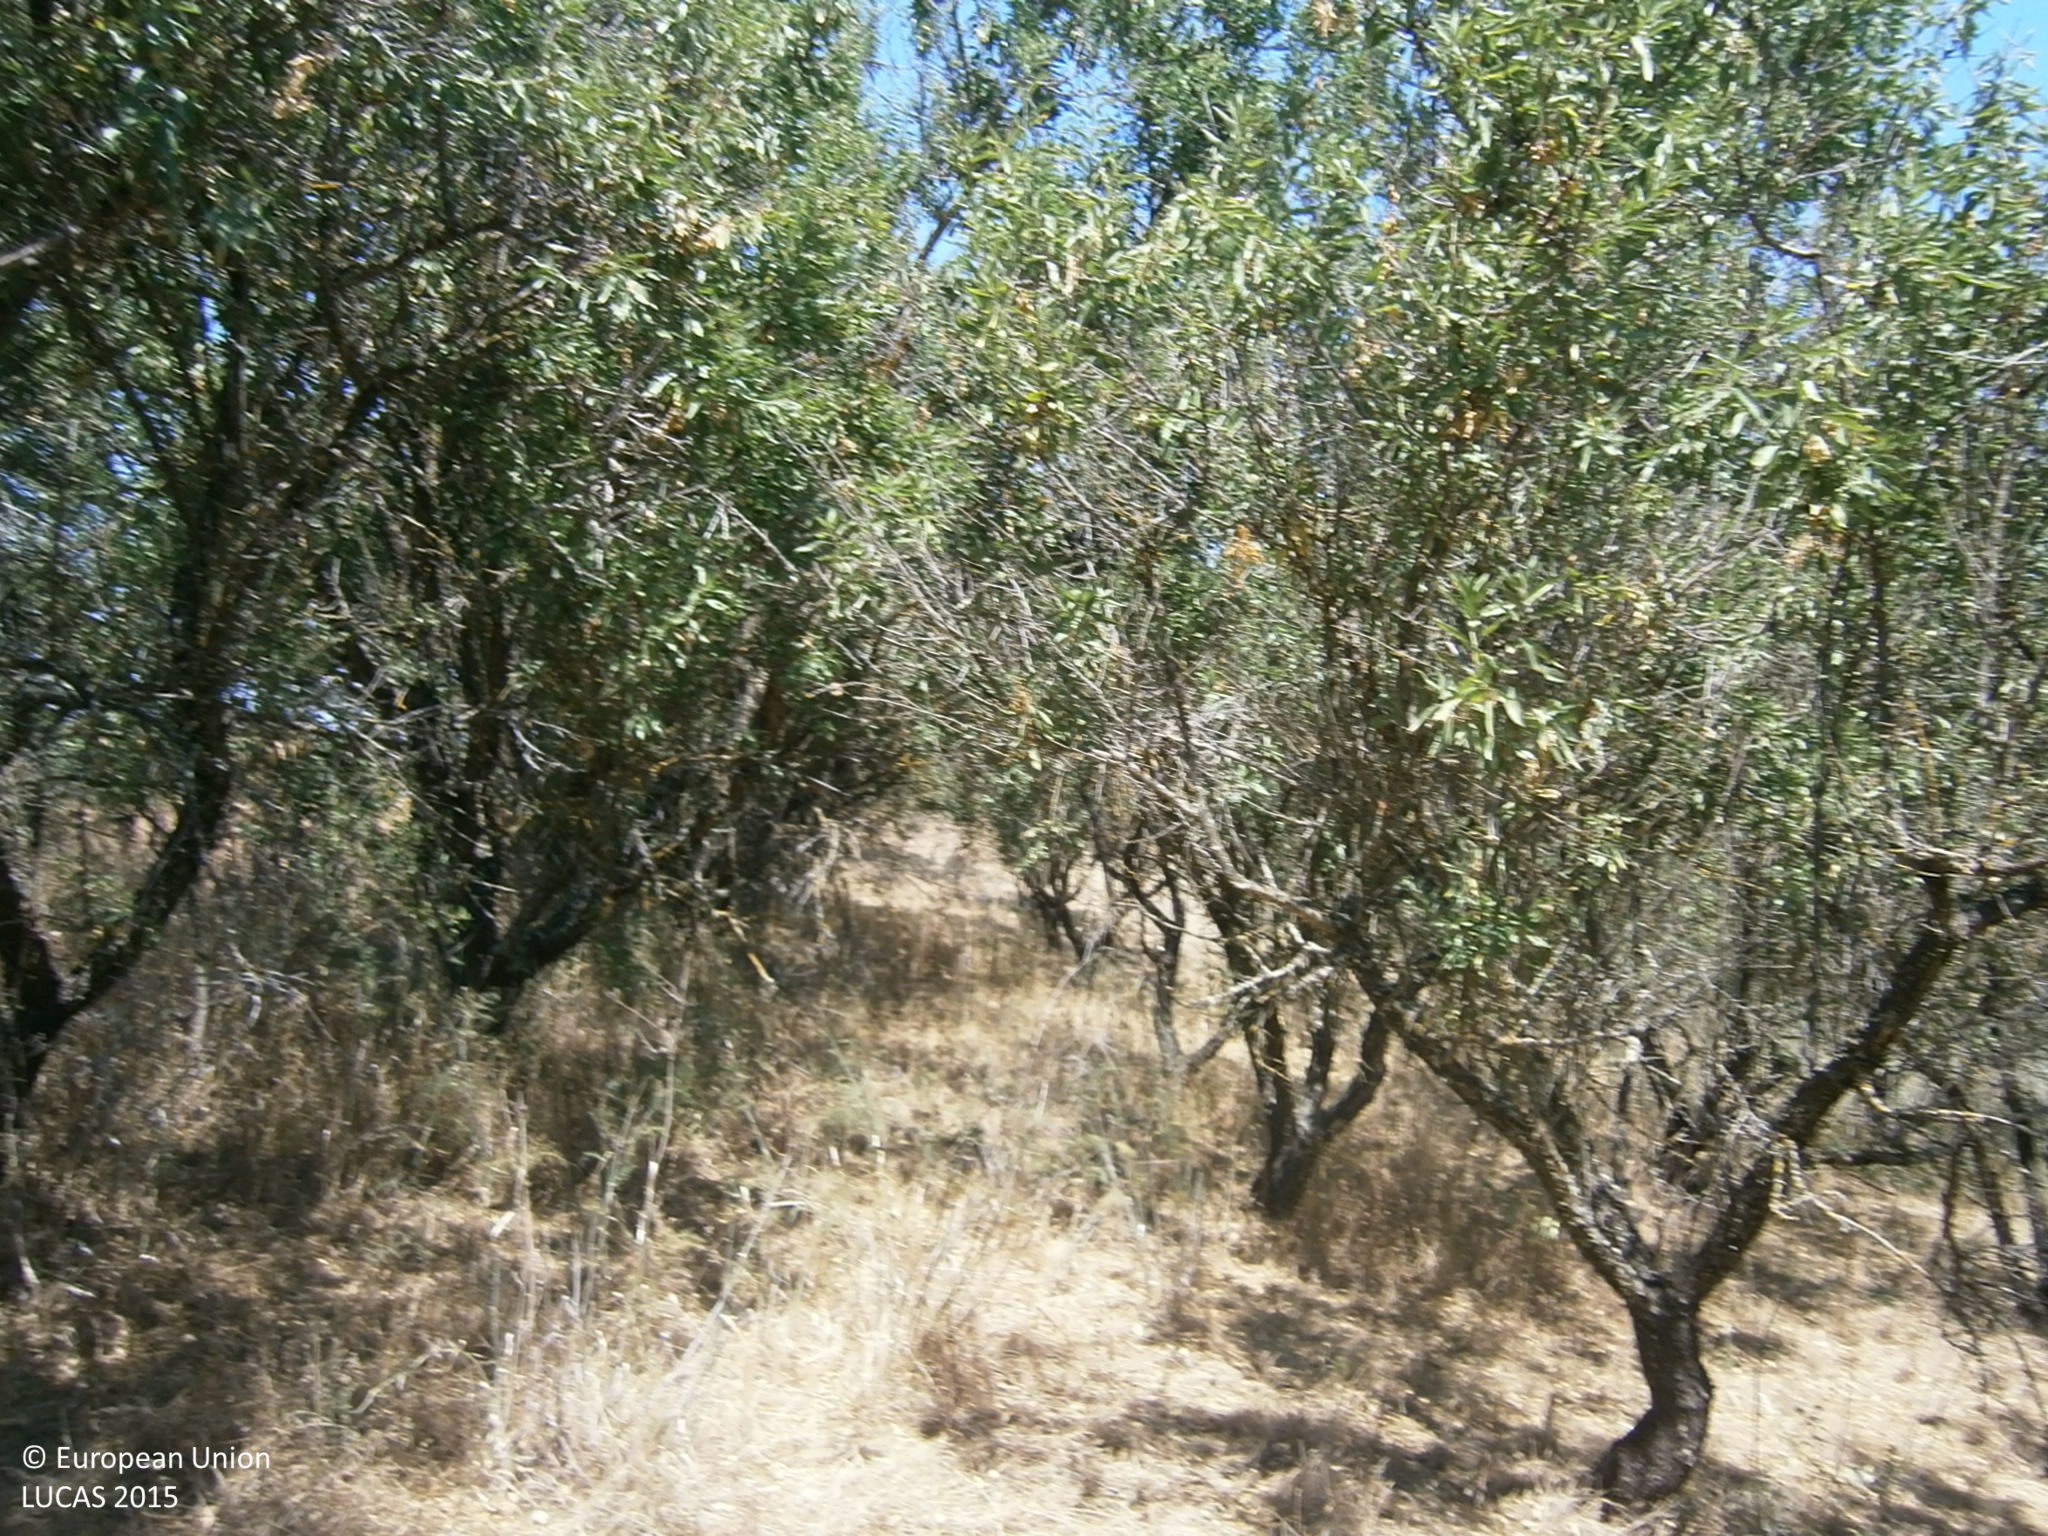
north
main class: Cropland
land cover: Nuts trees
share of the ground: > 75 %
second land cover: Spontaneously vegetated surfaces
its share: 25 - 50 %
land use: Agriculture (excluding fallow land and kitchen gardens)
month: June
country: ES
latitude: 38.8312
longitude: -6.6619
